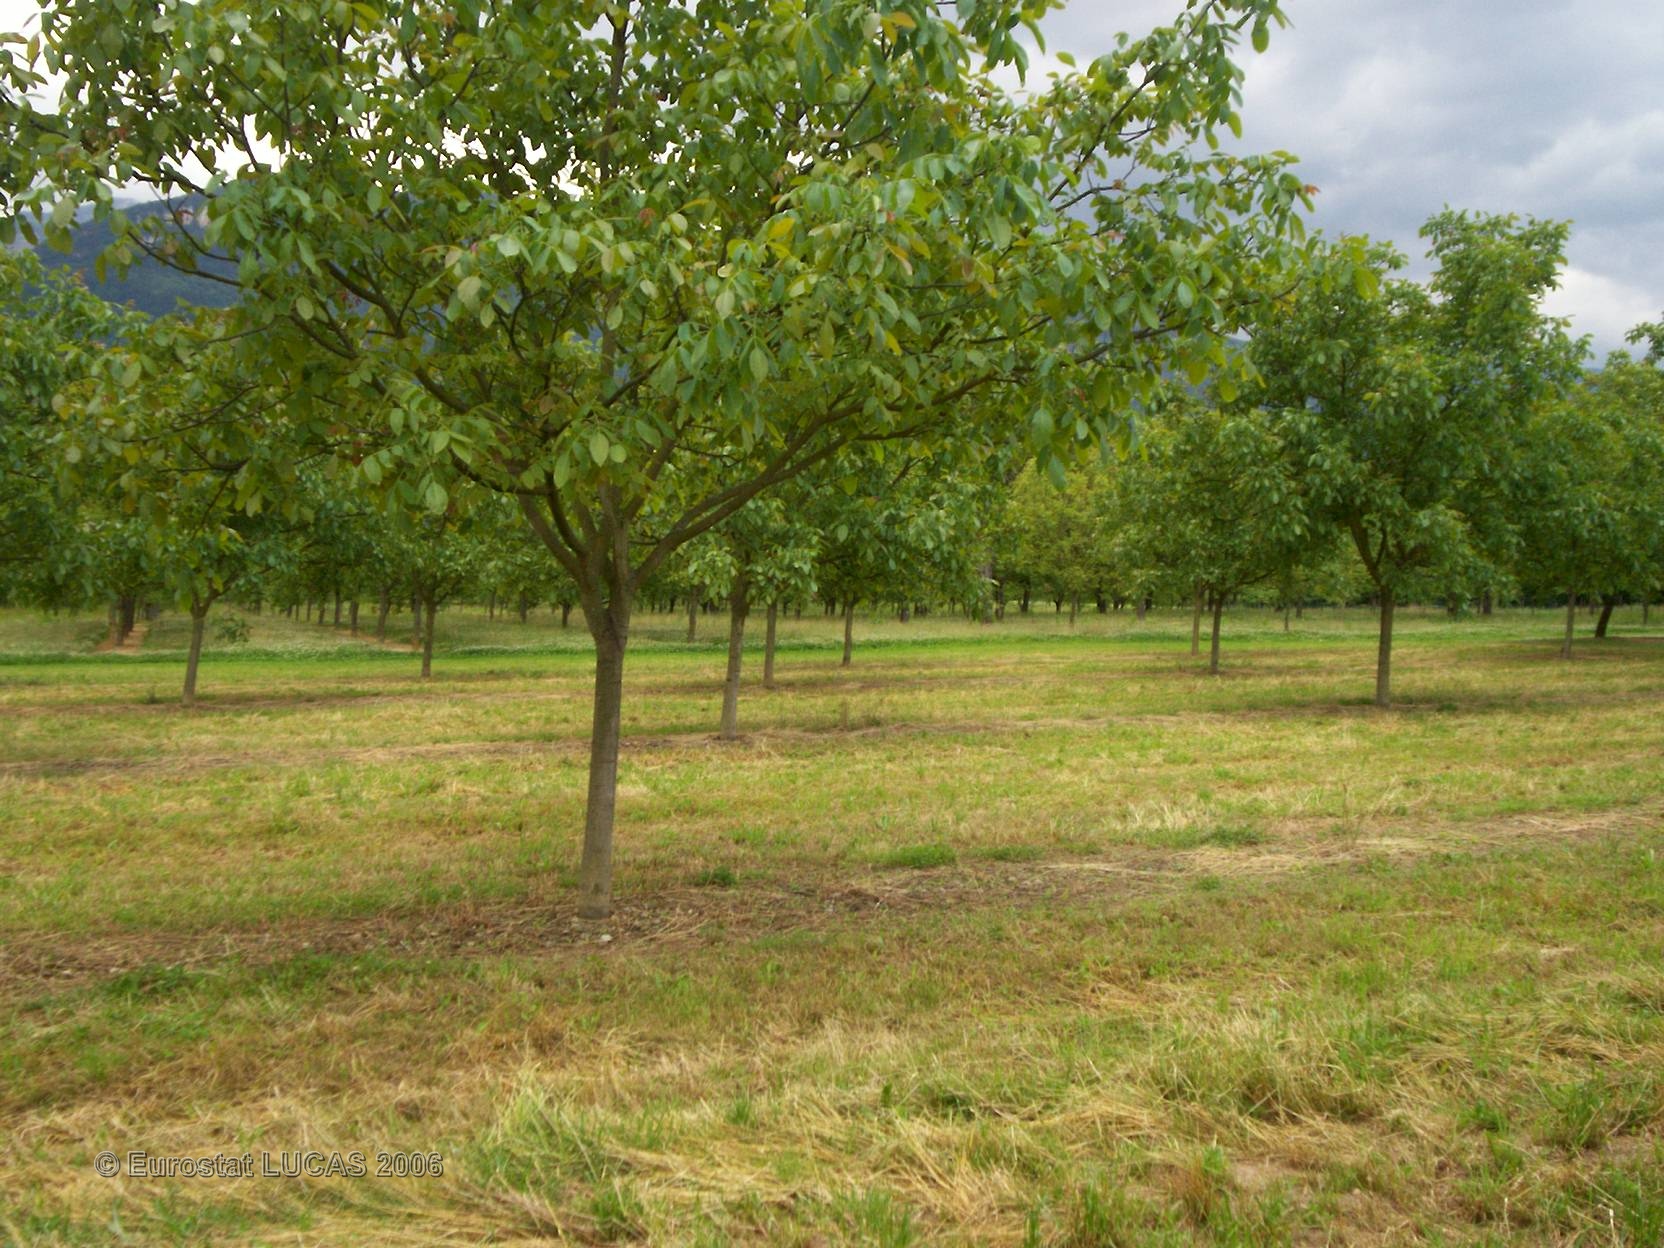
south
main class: Cropland
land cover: Nuts trees
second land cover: Grassland with sparse tree/shrub cover
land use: Agriculture (excluding fallow land and kitchen gardens)
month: June
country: FR
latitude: 45.2071
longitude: 5.4346
